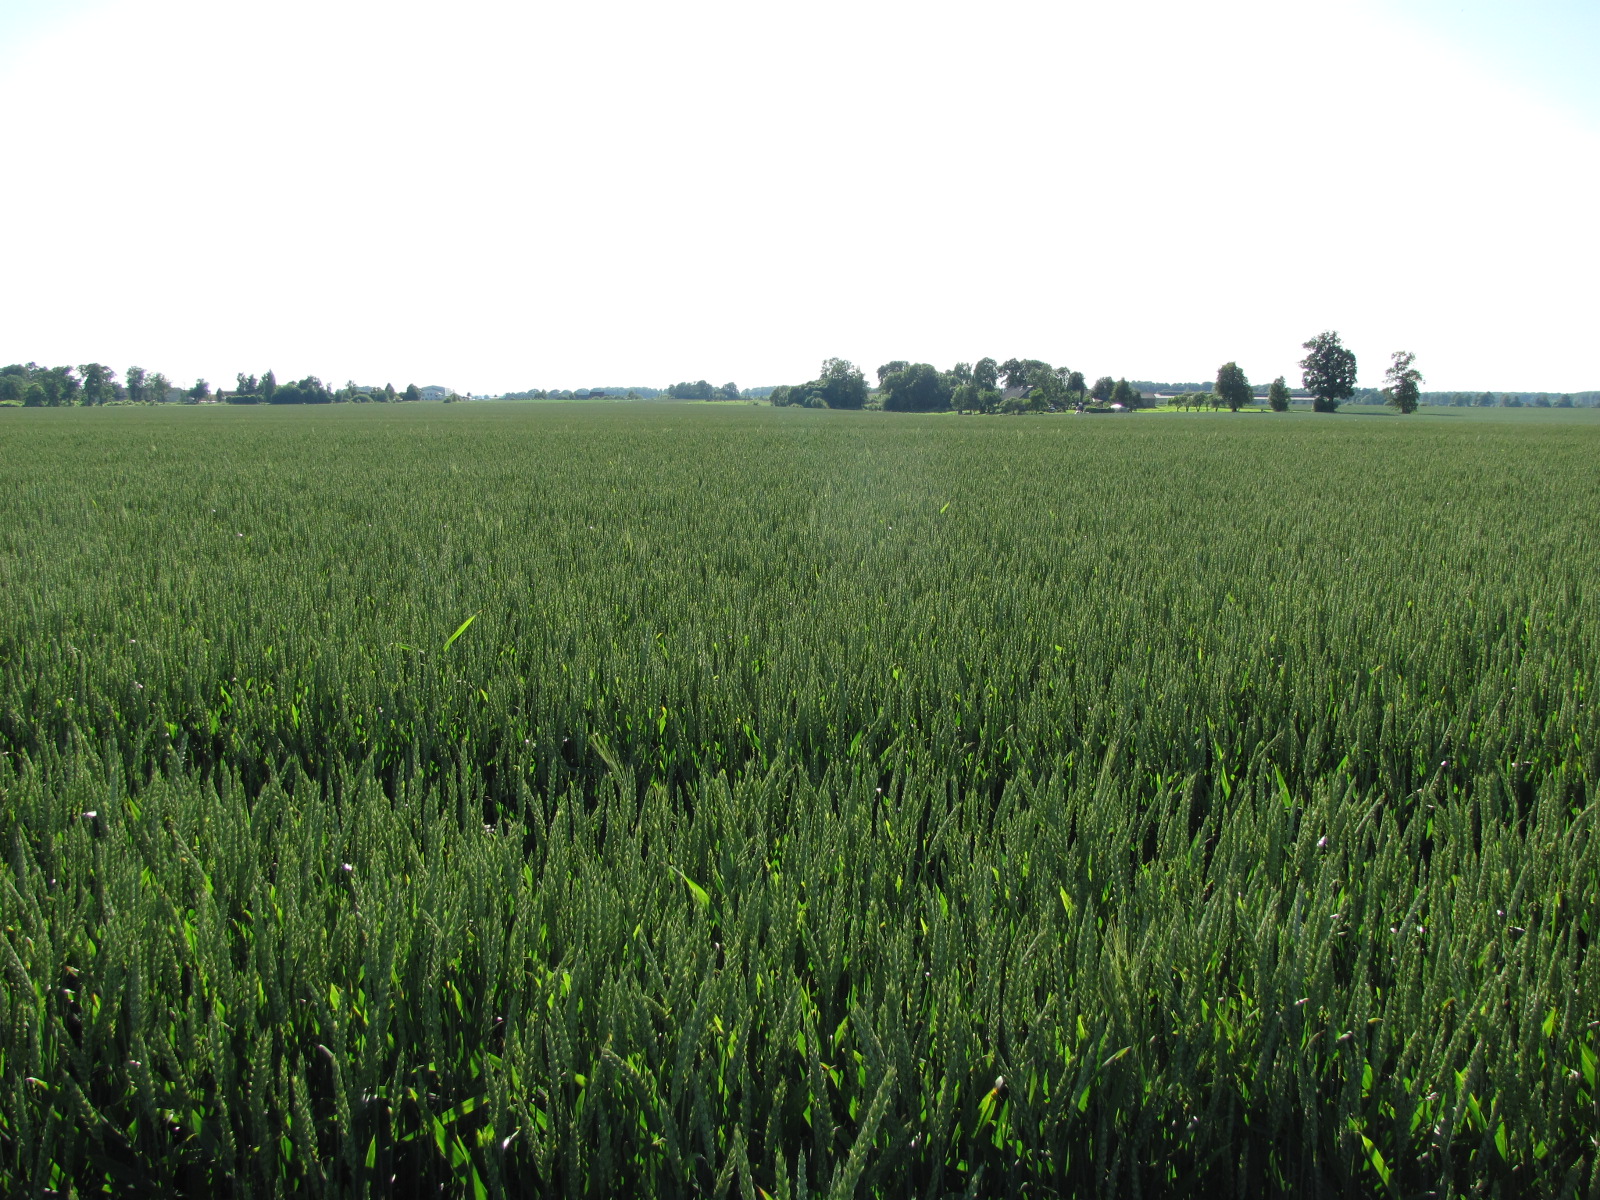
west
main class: Cropland
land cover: Common wheat
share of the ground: > 75 %
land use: Agriculture (excluding fallow land and kitchen gardens)
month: July
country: LV
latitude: 56.3840
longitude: 23.8325
